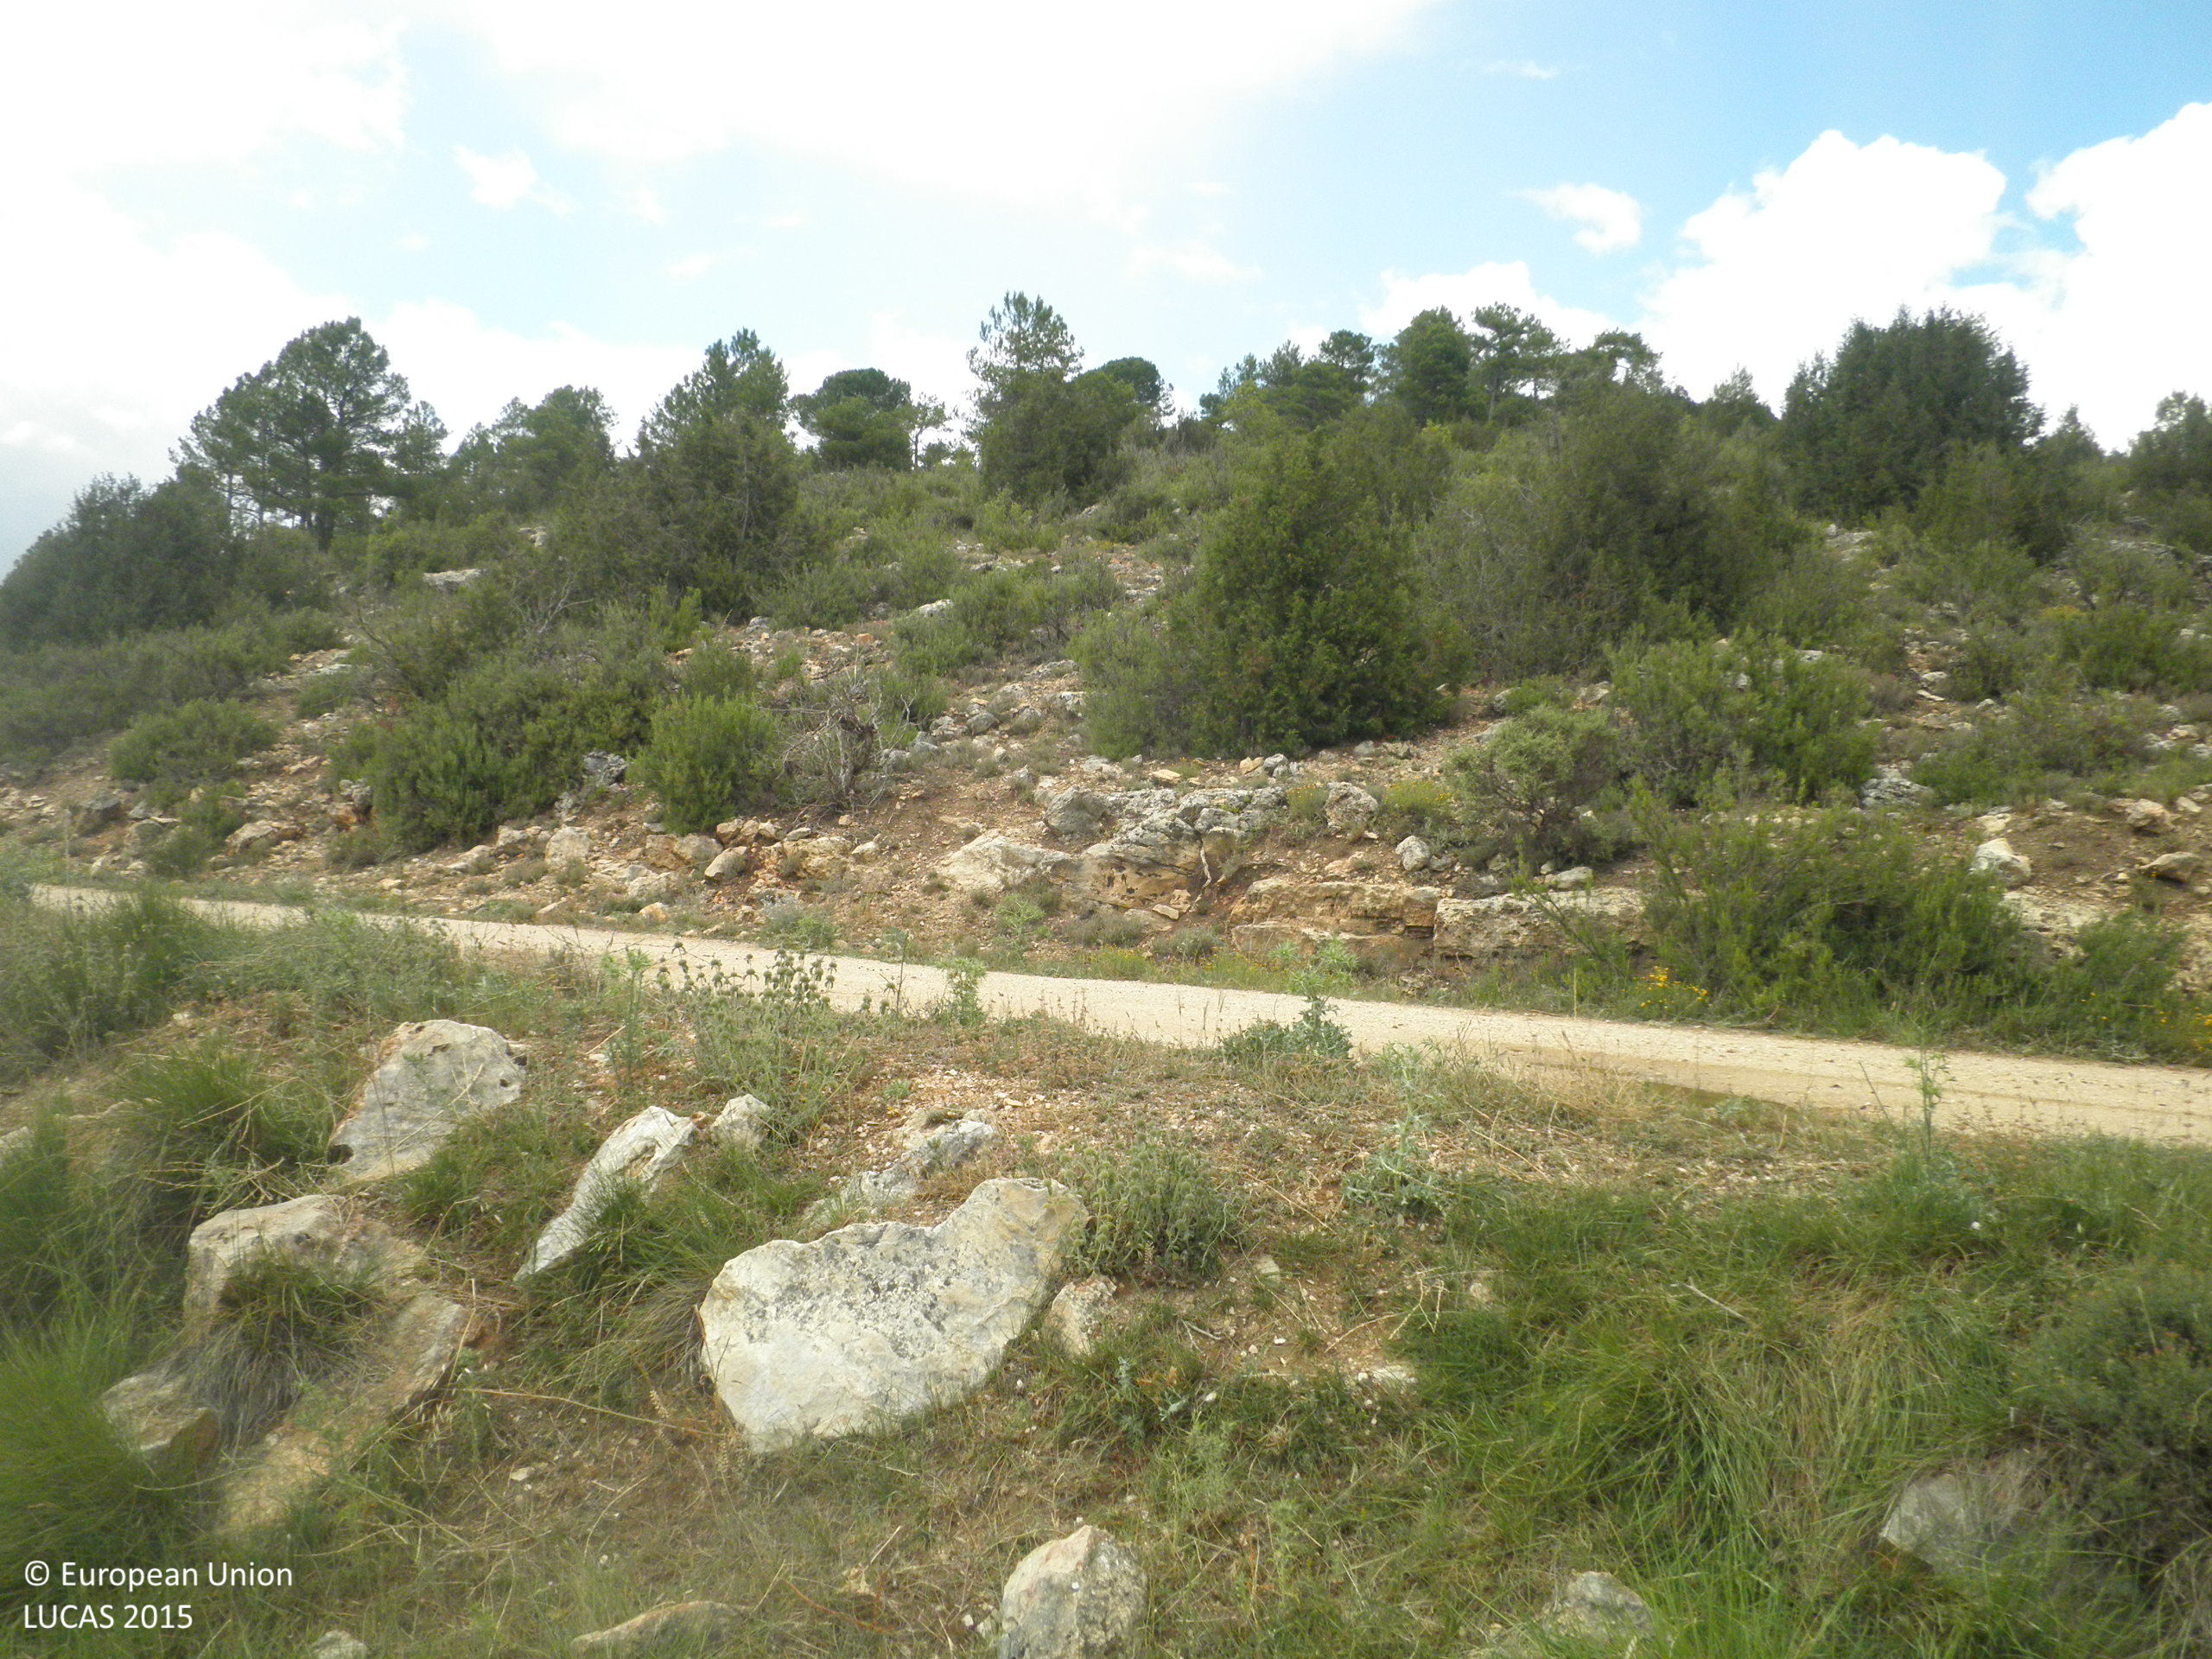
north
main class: Grassland
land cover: Spontaneously vegetated surfaces
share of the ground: > 75 %
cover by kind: herbaceous plants 90 %, unconsolidated bare surface 10 %
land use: Abandoned areas
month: June
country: ES
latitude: 39.7966
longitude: -1.7464
